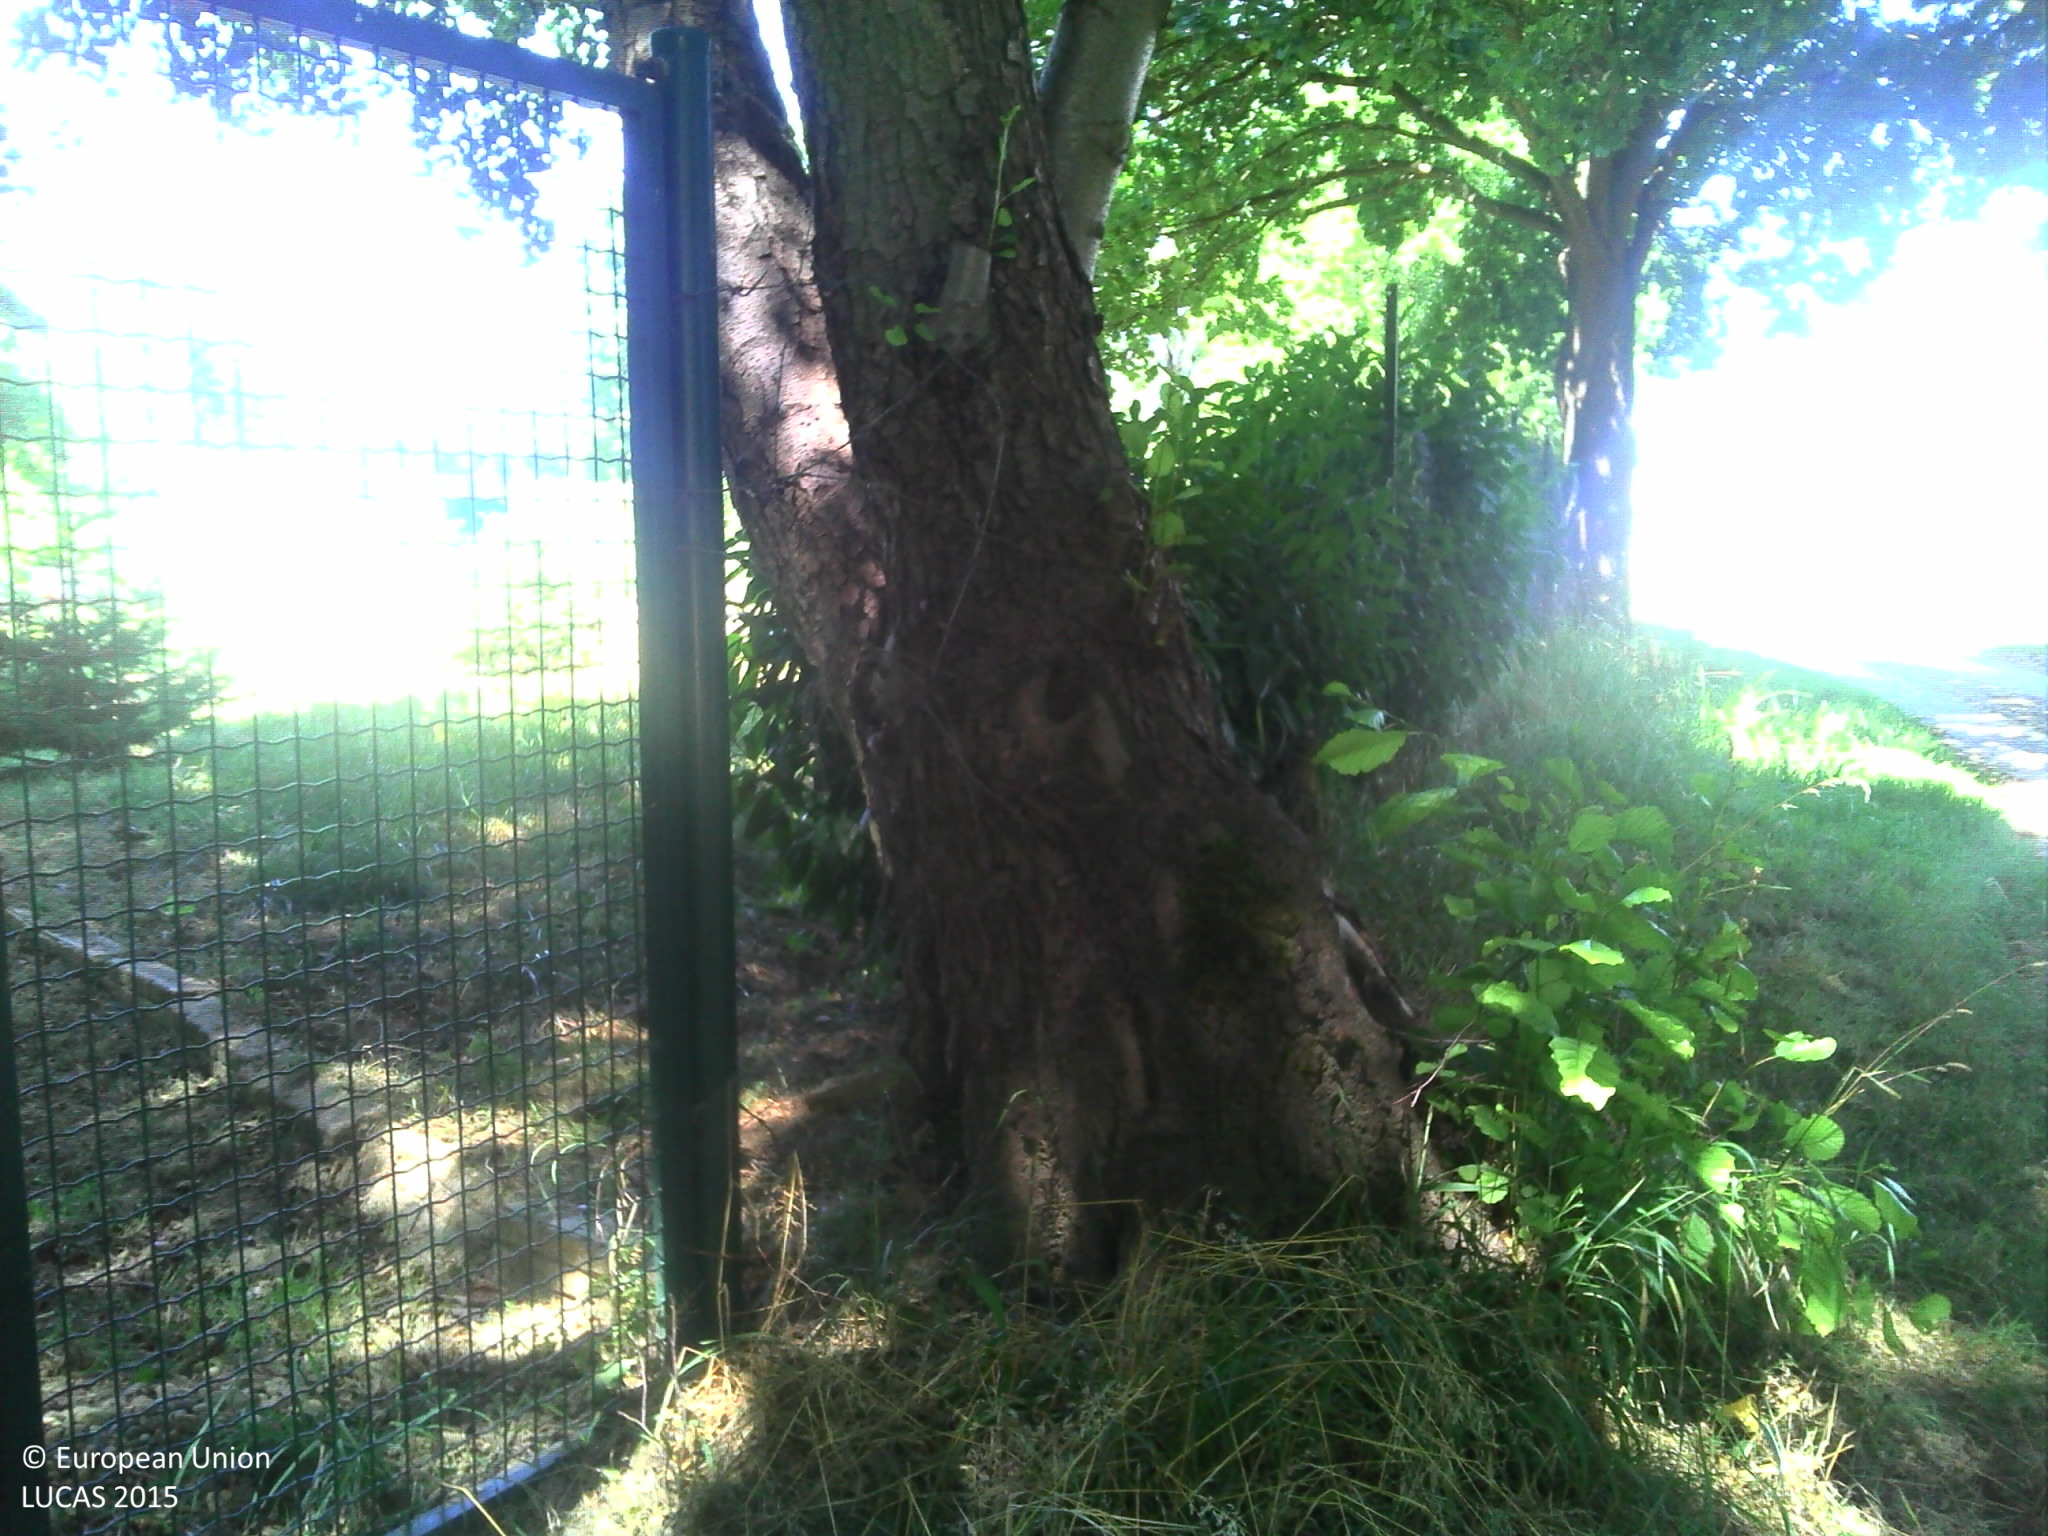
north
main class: Woodland
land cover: Broadleaved woodland
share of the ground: > 75 %
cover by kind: broadleaved forest trees 75 %, herbaceous plants 10 %, unconsolidated bare surface 10 %, shrubs 5 %
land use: Semi-natural and natural areas not in use
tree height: > 5 m
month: July
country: FR
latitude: 45.5793
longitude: 4.8906
